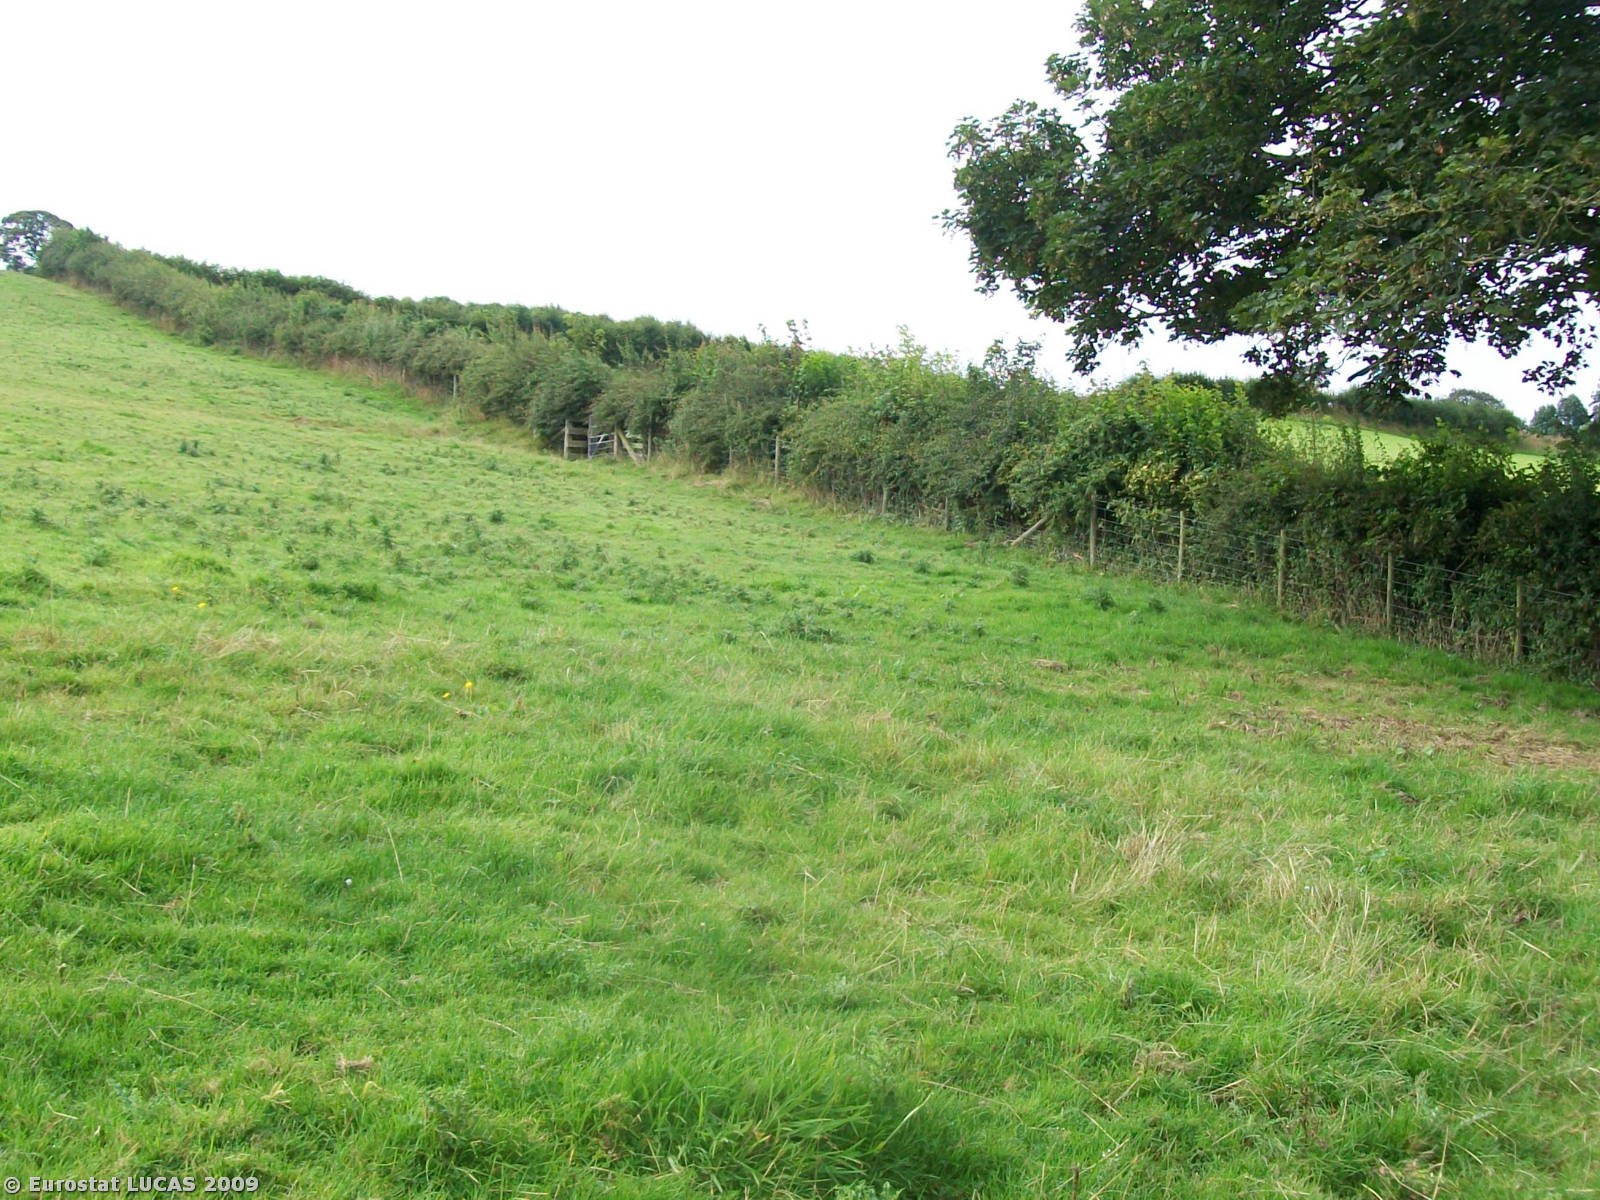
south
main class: Grassland
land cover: Grassland without tree/shrub cover
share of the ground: > 75 %
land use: Agriculture (excluding fallow land and kitchen gardens)
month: August
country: GB
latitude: 52.6448
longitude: -3.3082
